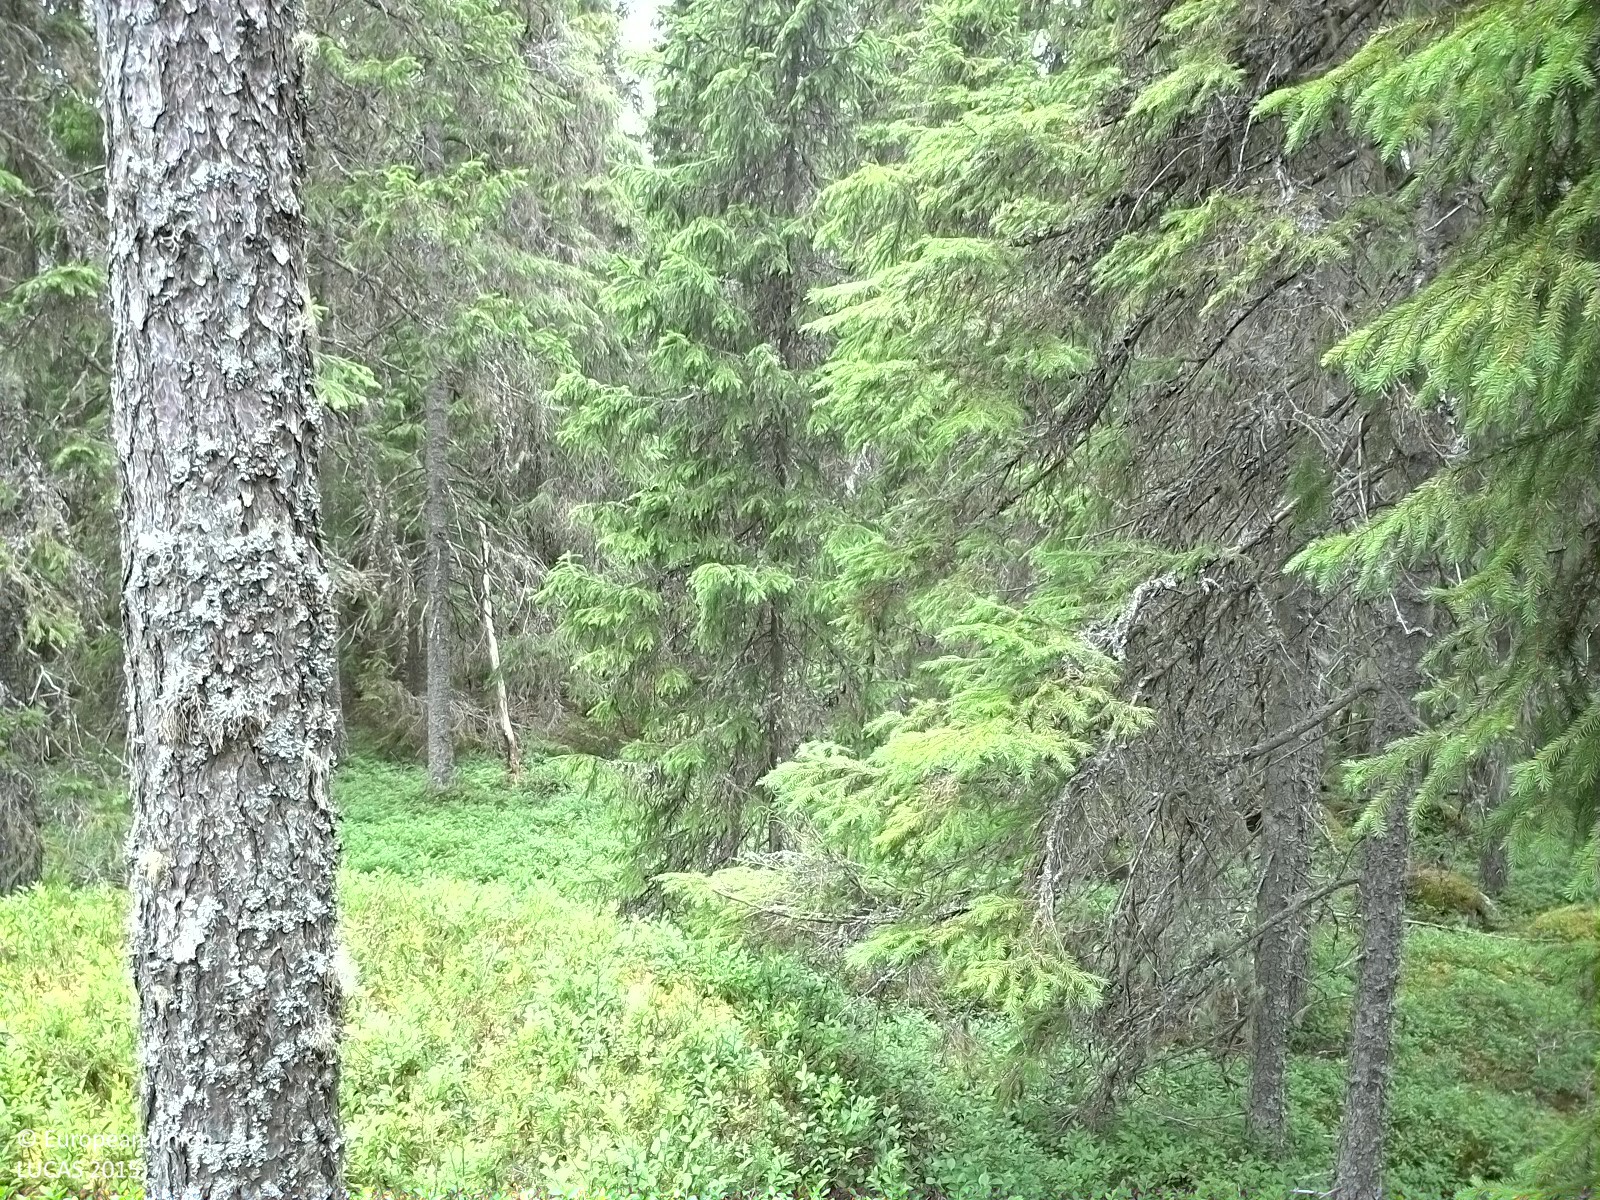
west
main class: Woodland
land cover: Spruce dominated coniferous woodland
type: boreal forest
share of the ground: 50 - 75 %
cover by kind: coniferous forest trees 50 %, herbaceous plants 40 %, lichens and mosses 10 %
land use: Forestry
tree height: > 5 m
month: July
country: SE
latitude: 62.5064
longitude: 17.6890
